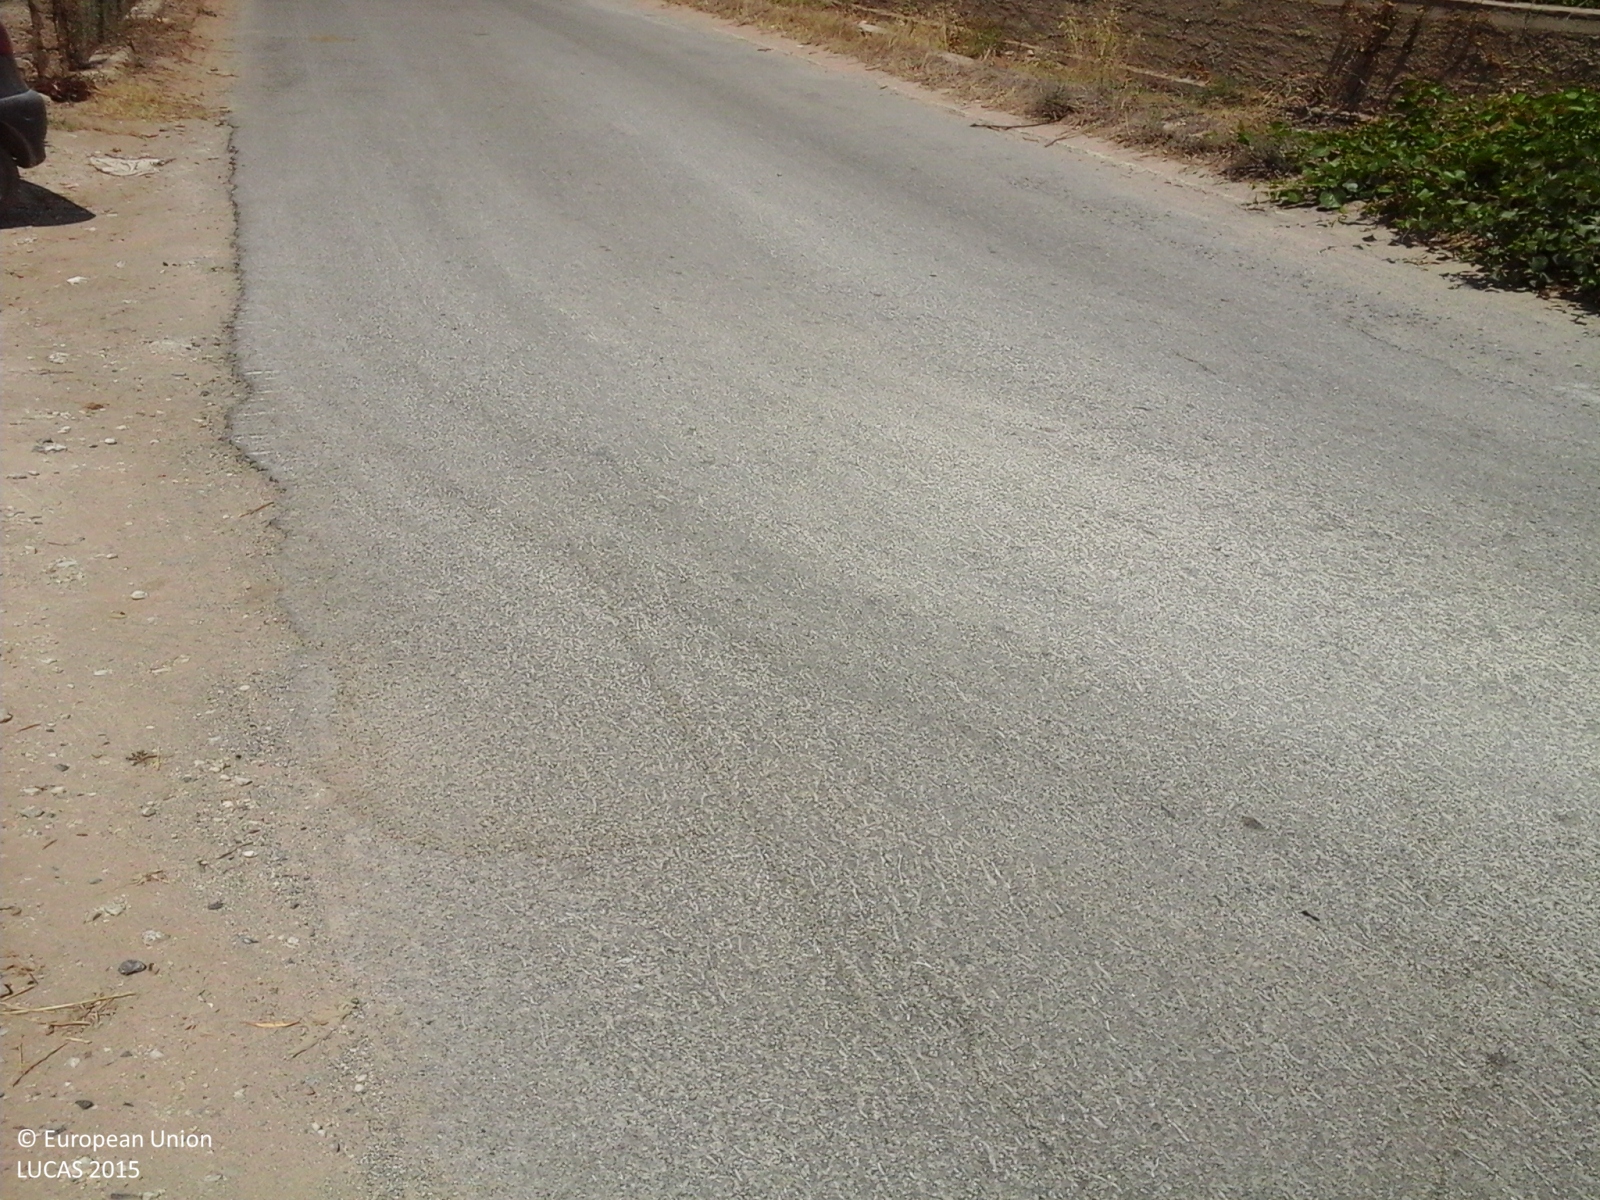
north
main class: Cropland
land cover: Durum wheat
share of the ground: > 75 %
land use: Agriculture (excluding fallow land and kitchen gardens)
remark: Burnt area
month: July
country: IT
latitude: 37.1541
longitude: 14.4133
